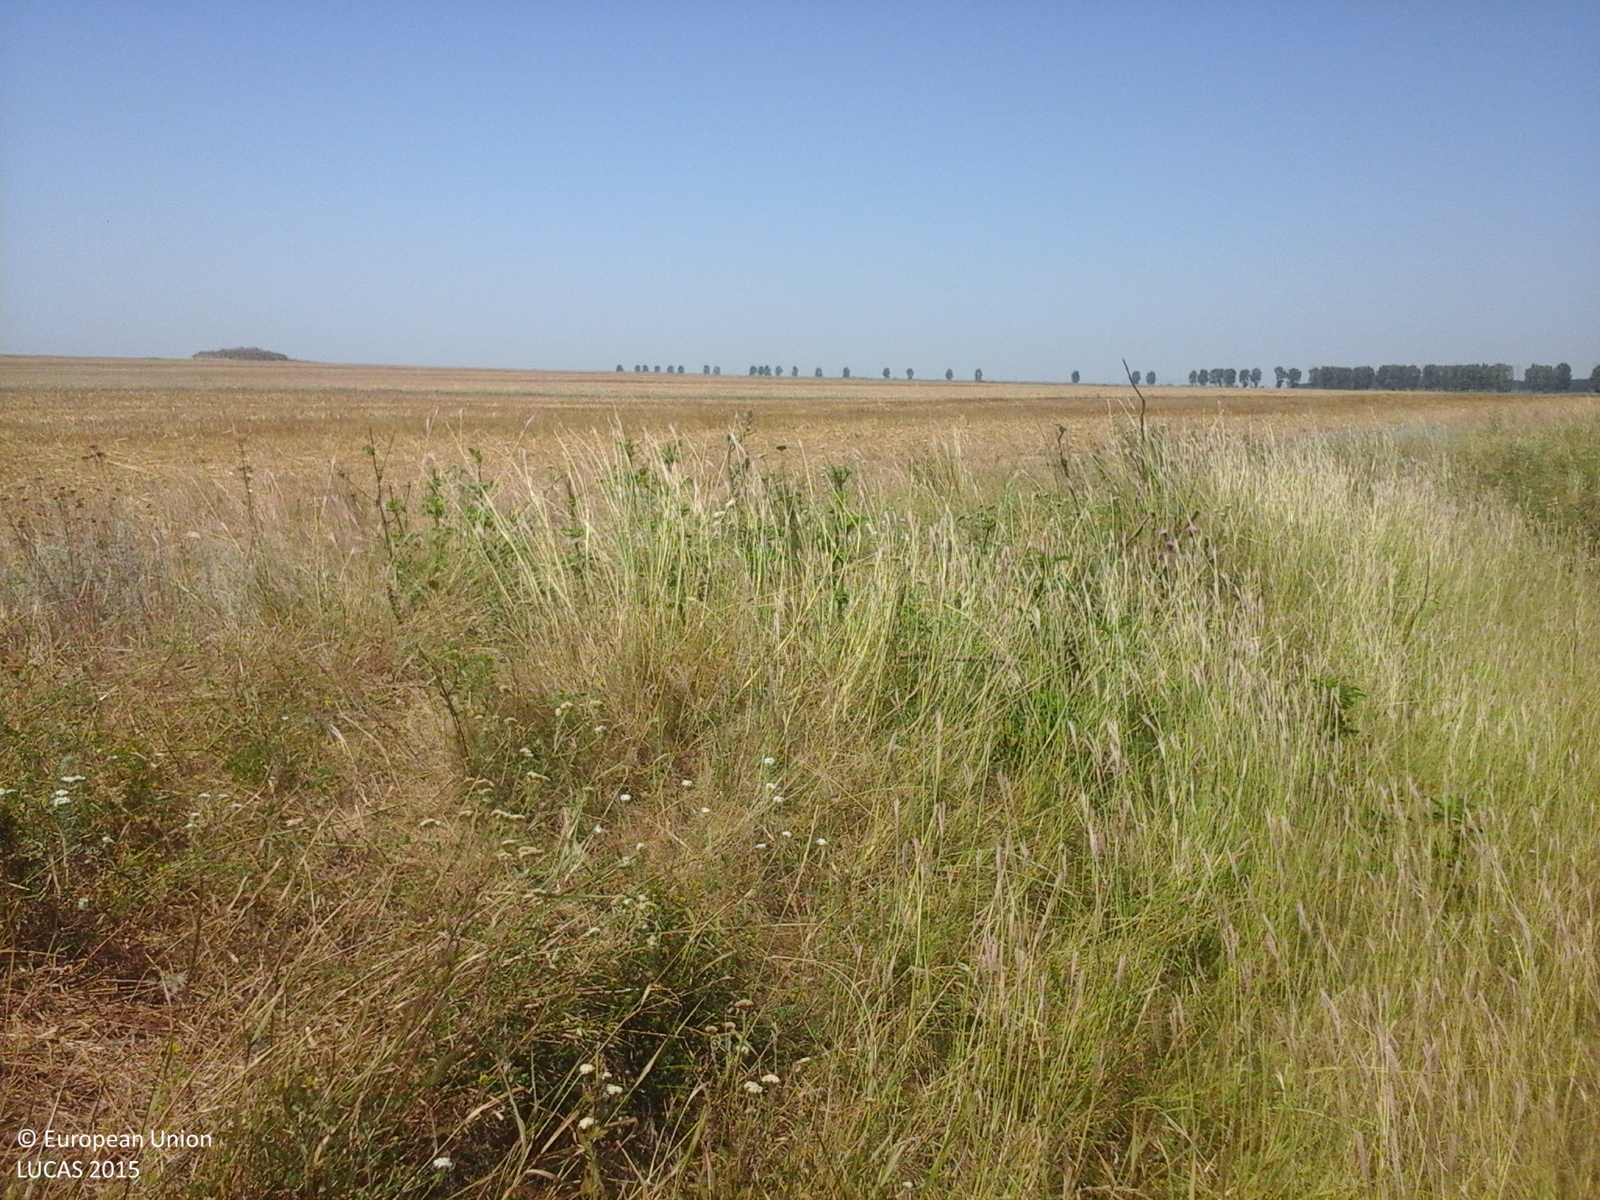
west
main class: Grassland
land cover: Spontaneously vegetated surfaces
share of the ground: > 75 %
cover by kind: herbaceous plants 100 %
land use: Fallow land
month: July
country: RO
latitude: 44.2196
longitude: 26.5746
